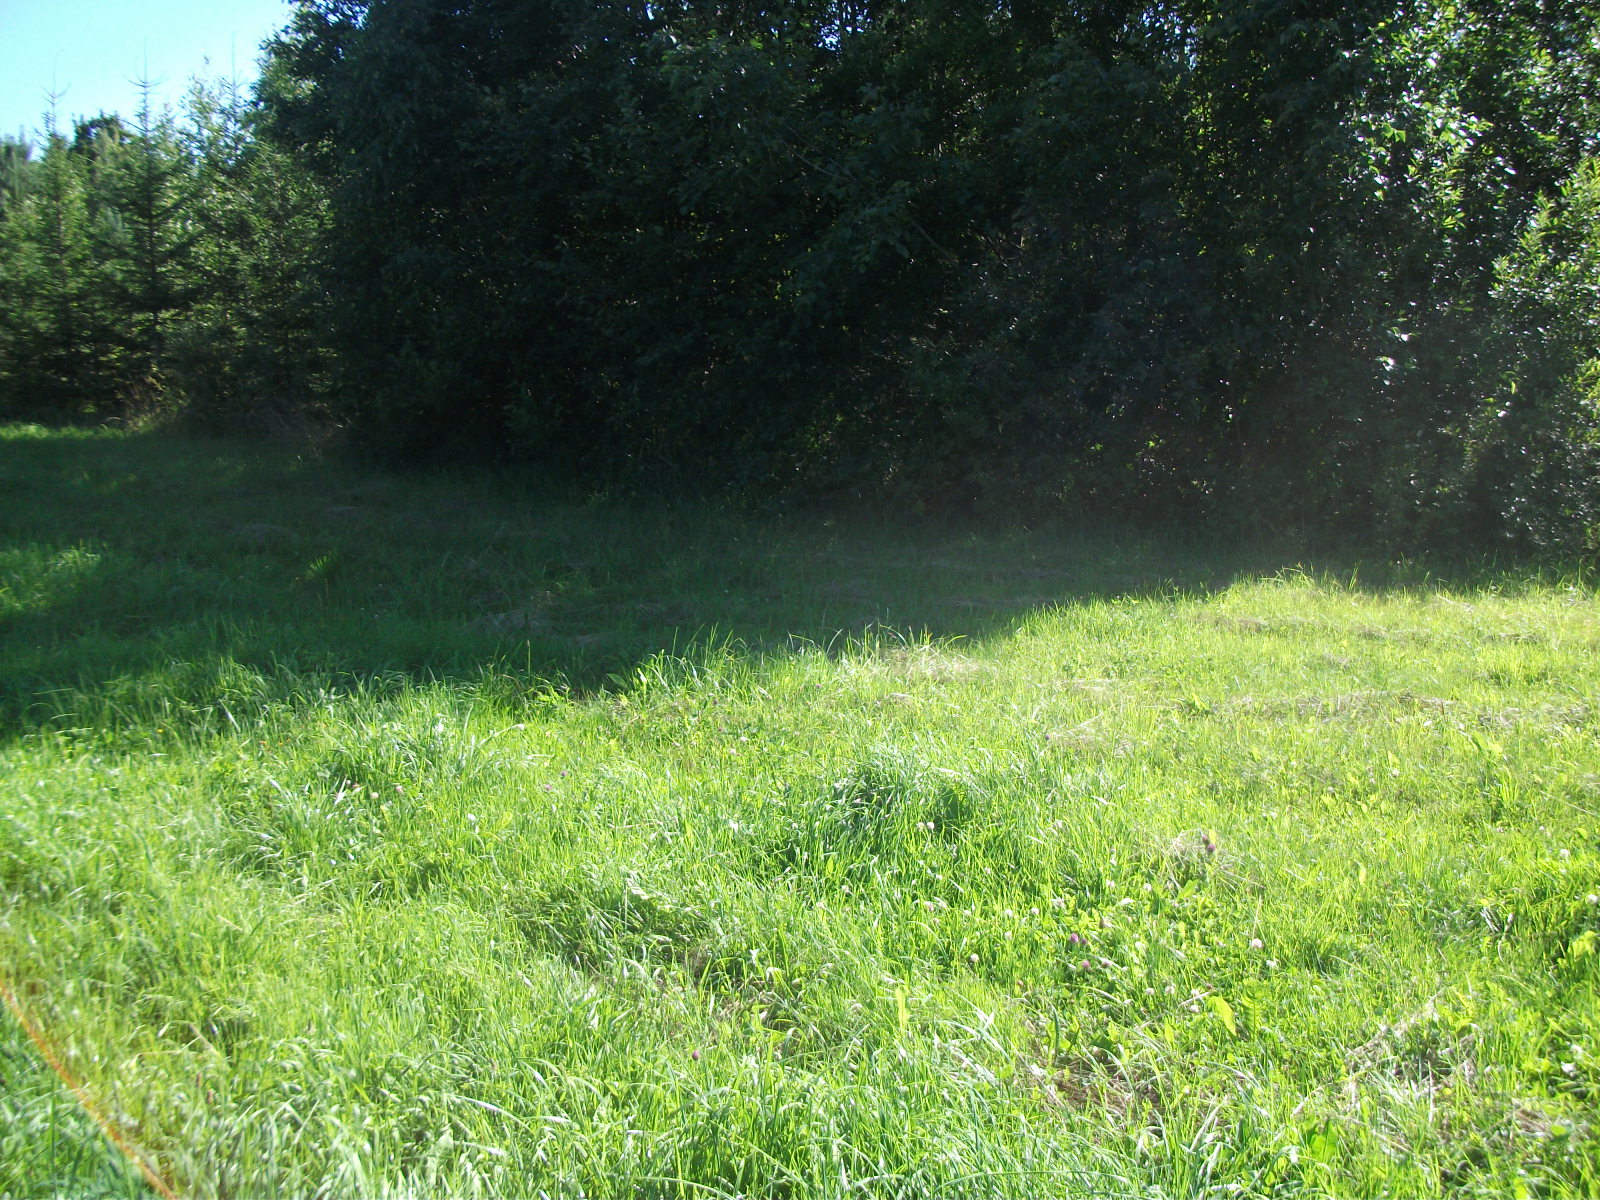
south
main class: Grassland
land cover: Grassland without tree/shrub cover
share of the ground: > 75 %
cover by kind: herbaceous plants 100 %
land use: Agriculture (excluding fallow land and kitchen gardens)
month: August
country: LV
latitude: 56.9249
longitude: 26.2561
